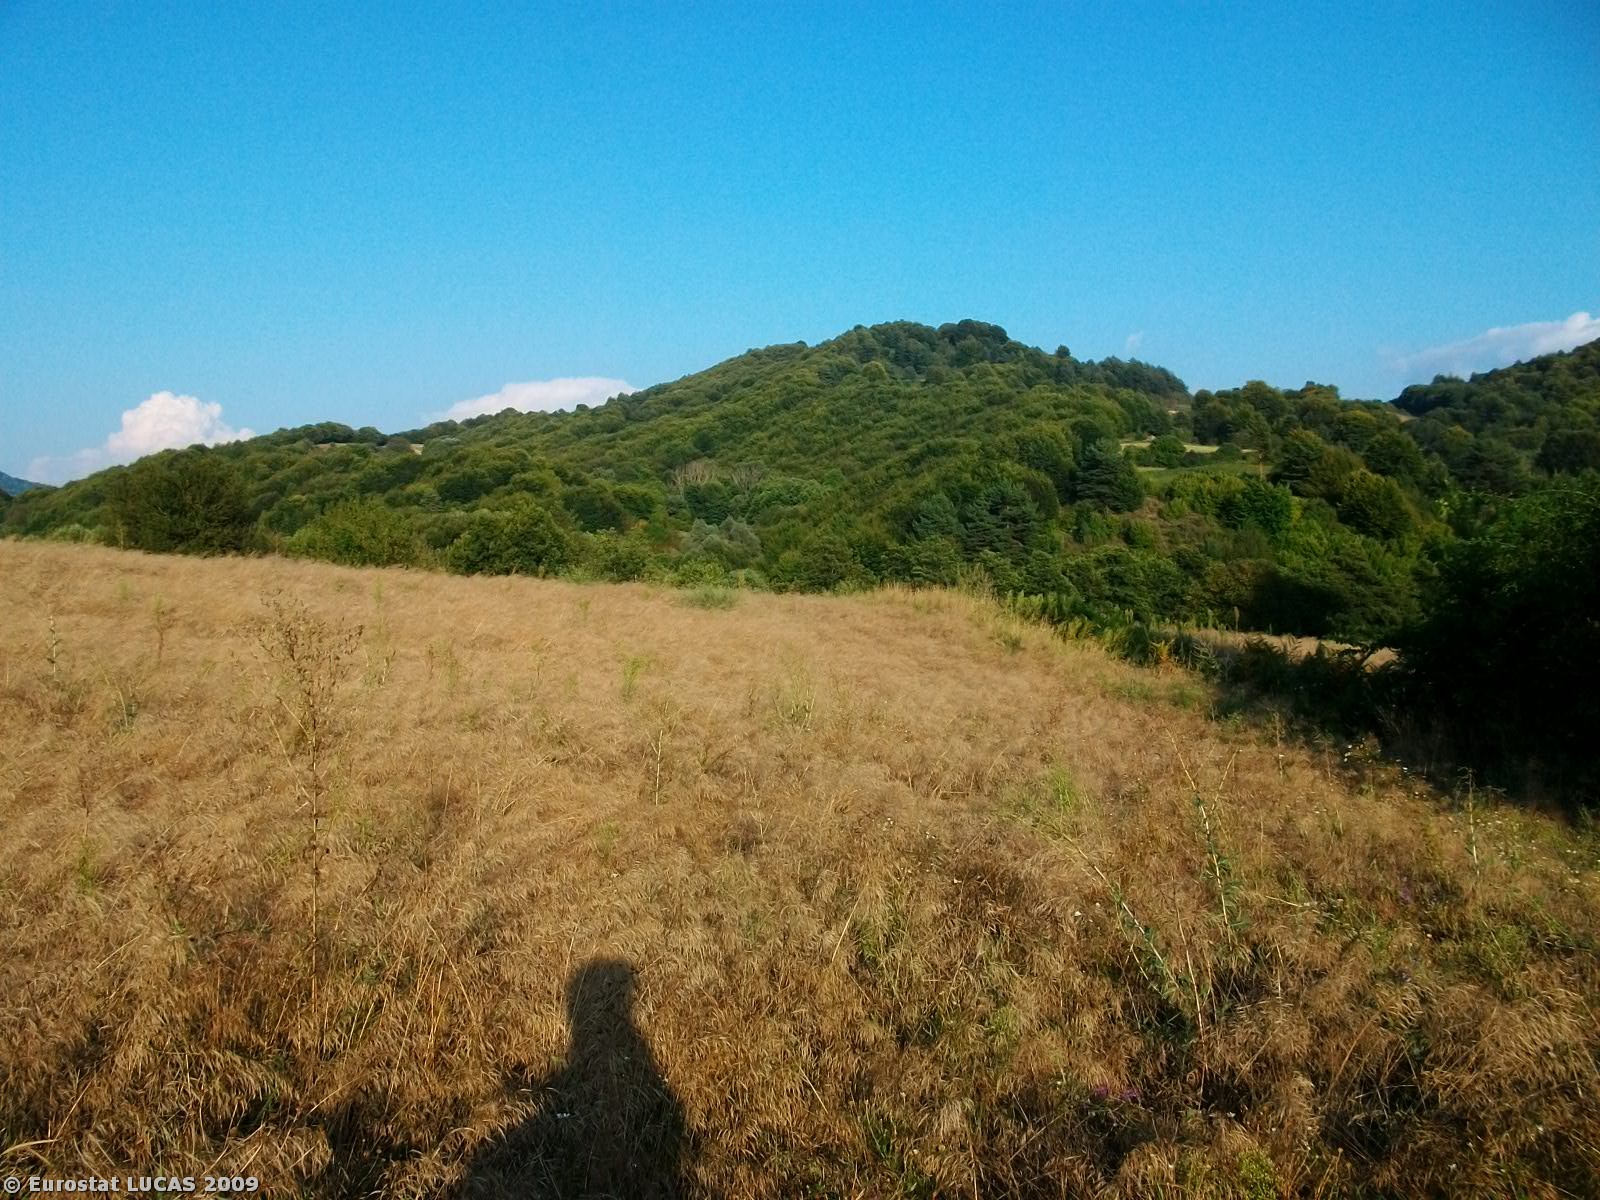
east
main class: Grassland
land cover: Grassland without tree/shrub cover
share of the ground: > 75 %
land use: Unused
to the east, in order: Grassland without tree/shrub cover; Potatoes; Grassland without tree/shrub cover; Tracks; Grassland without tree/shrub cover; Broadleaved woodland; Rivers and streams; Broadleaved woodland; Grassland without tree/shrub cover; Shruby margins; Tracks; Broadleaved woodland
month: September
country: GR
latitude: 41.2798
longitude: 23.6946
